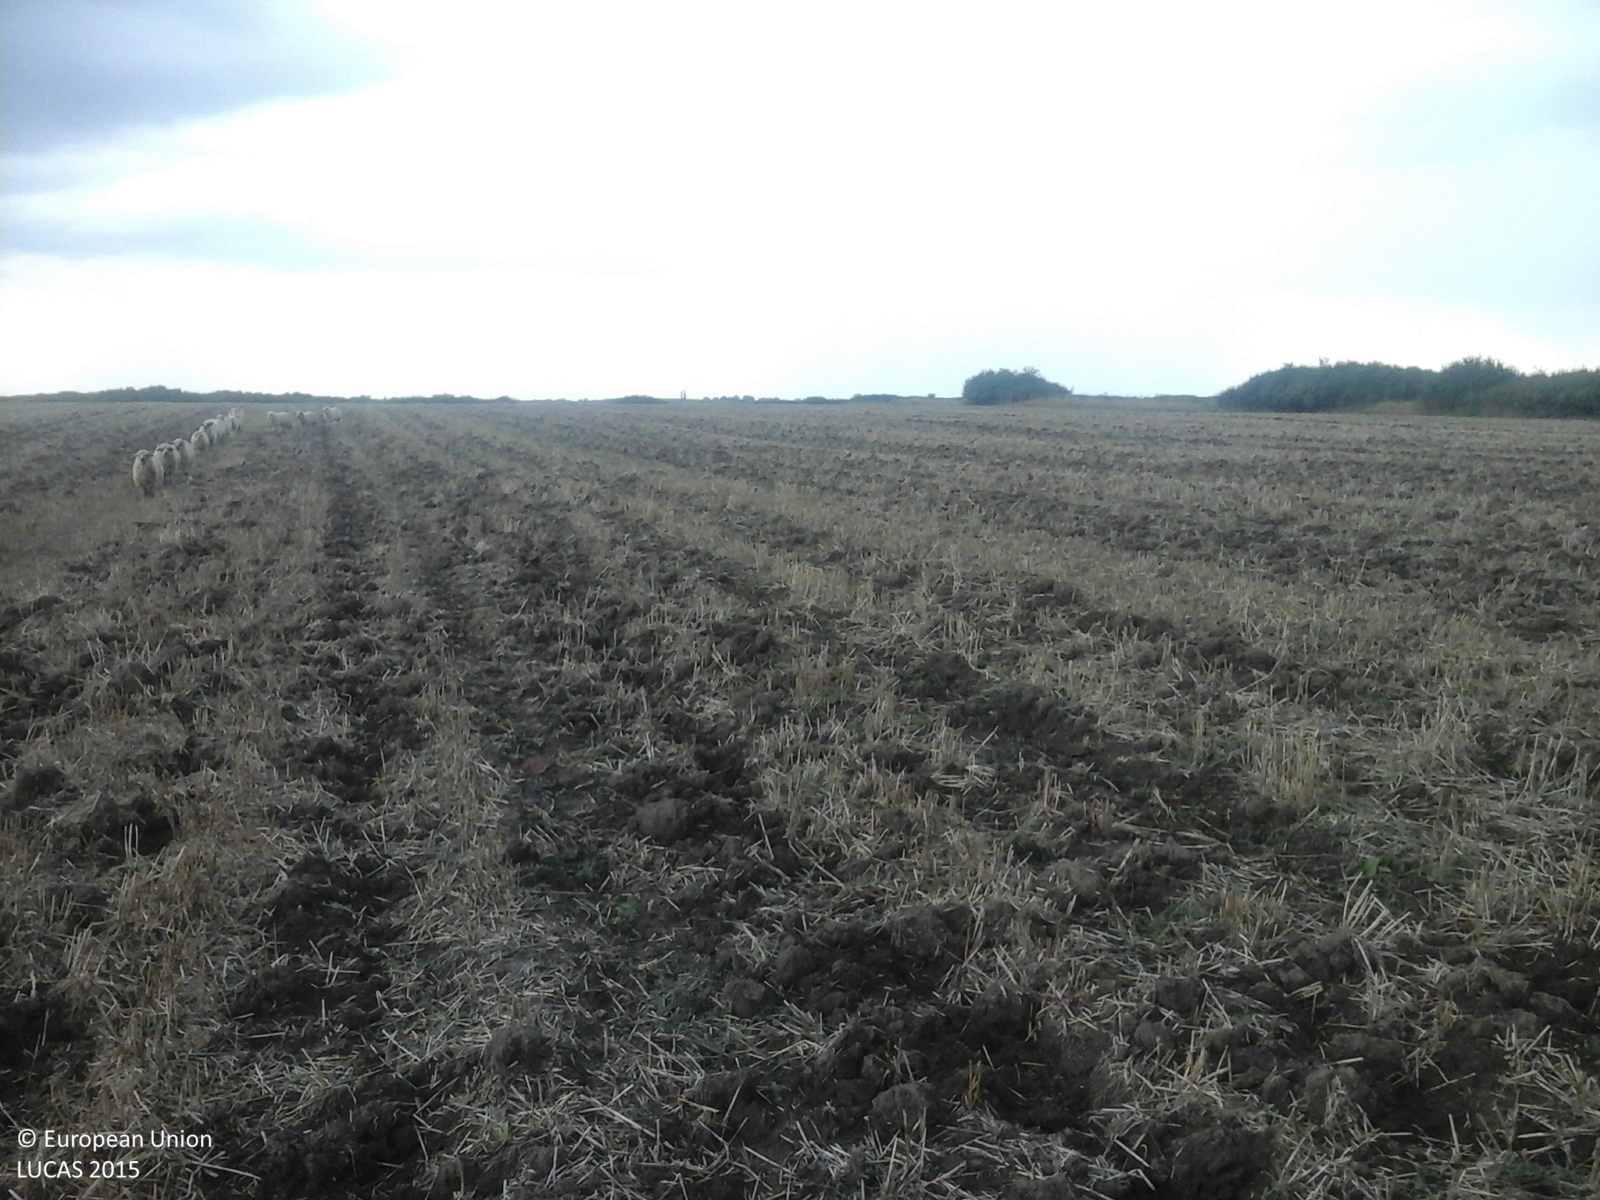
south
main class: Cropland
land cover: Oats
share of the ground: 10 - 25 %
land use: Agriculture (excluding fallow land and kitchen gardens)
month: August
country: RO
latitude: 45.4814
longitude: 21.0939
